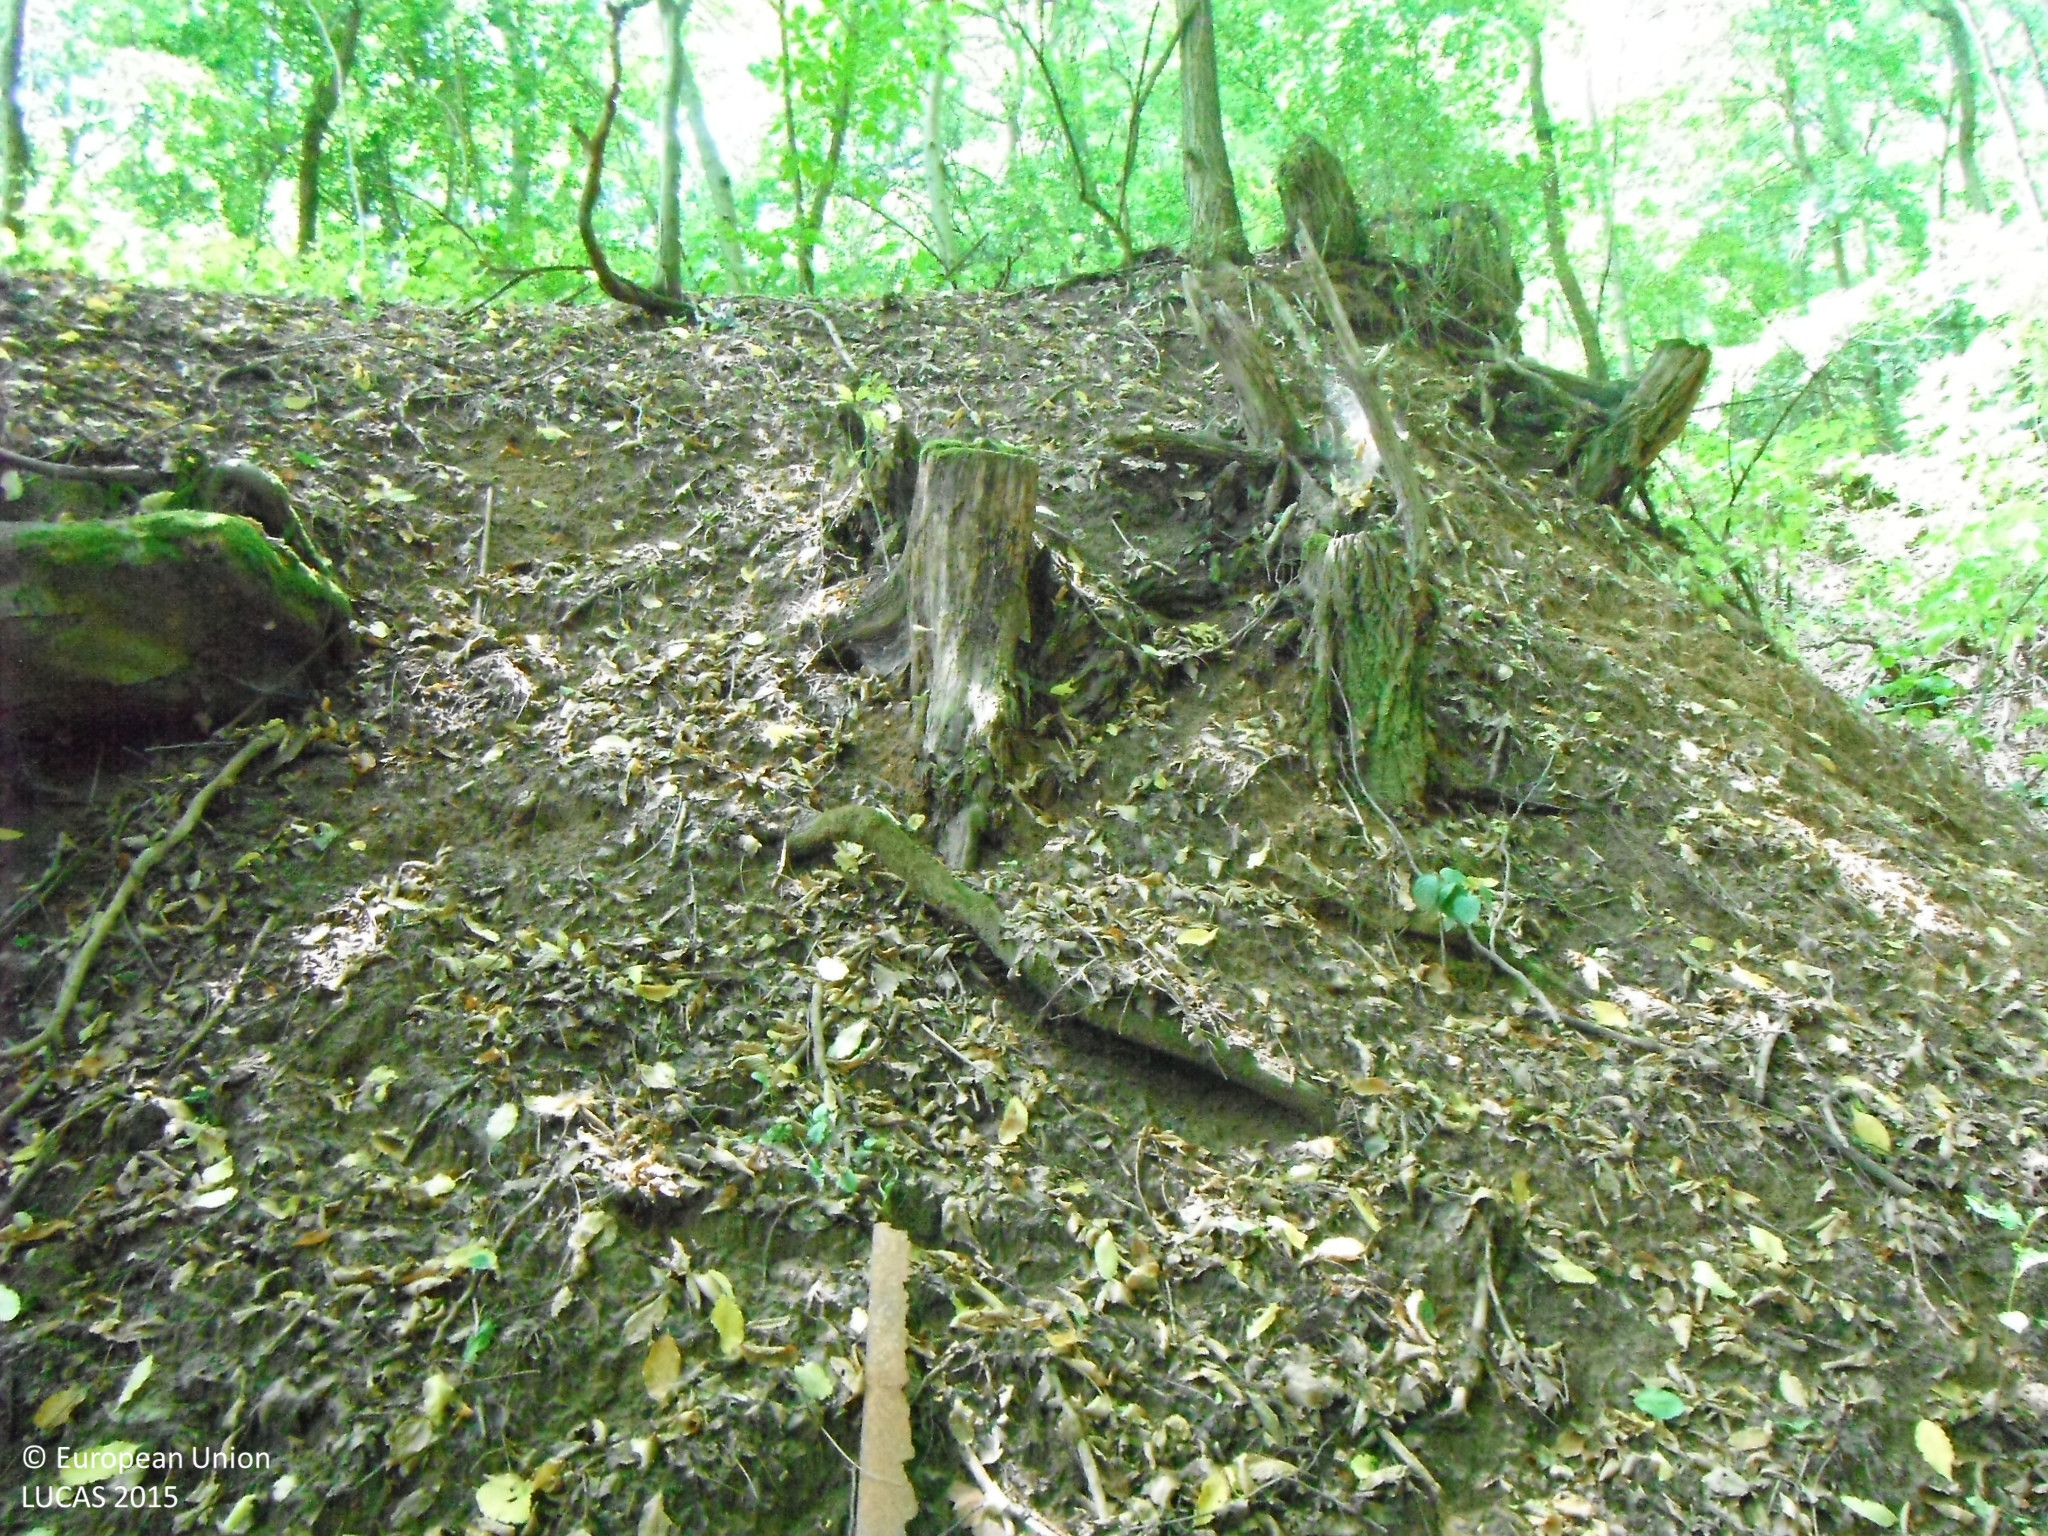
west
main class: Woodland
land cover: Broadleaved woodland
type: exotic forest
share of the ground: > 75 %
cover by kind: broadleaved forest trees 100 %
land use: Forestry
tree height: > 5 m
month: July
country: SK
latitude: 48.2054
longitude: 19.9723
